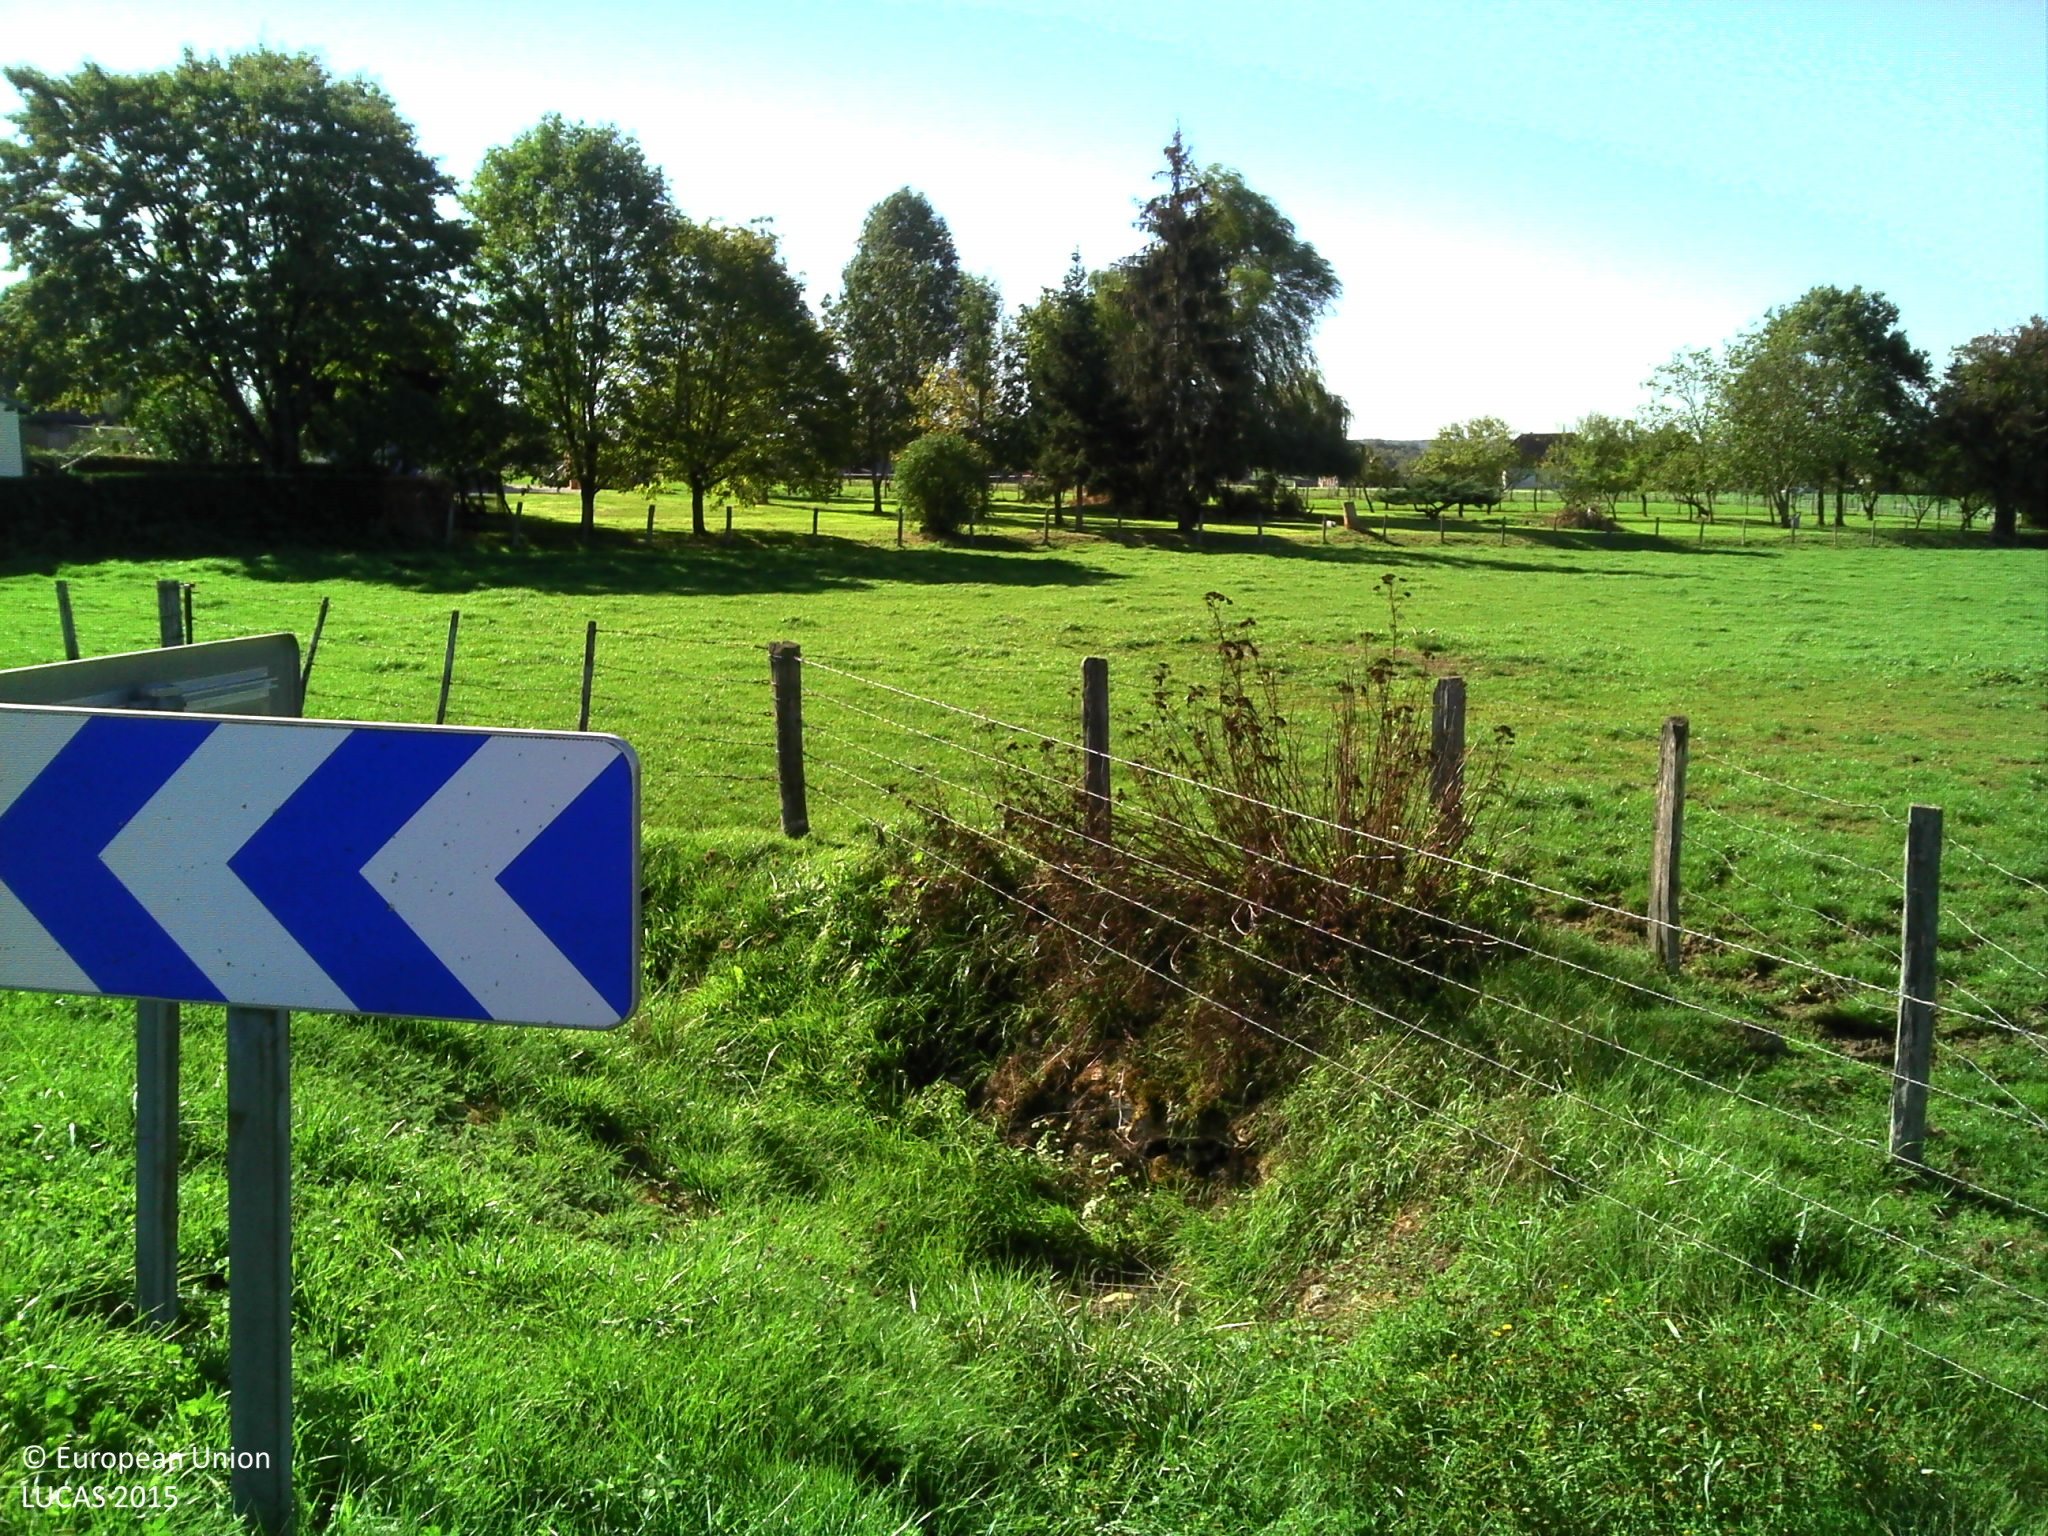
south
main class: Grassland
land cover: Grassland without tree/shrub cover
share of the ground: > 75 %
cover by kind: herbaceous plants 100 %
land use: Agriculture (excluding fallow land and kitchen gardens)
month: September
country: FR
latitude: 48.2427
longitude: 4.3821
